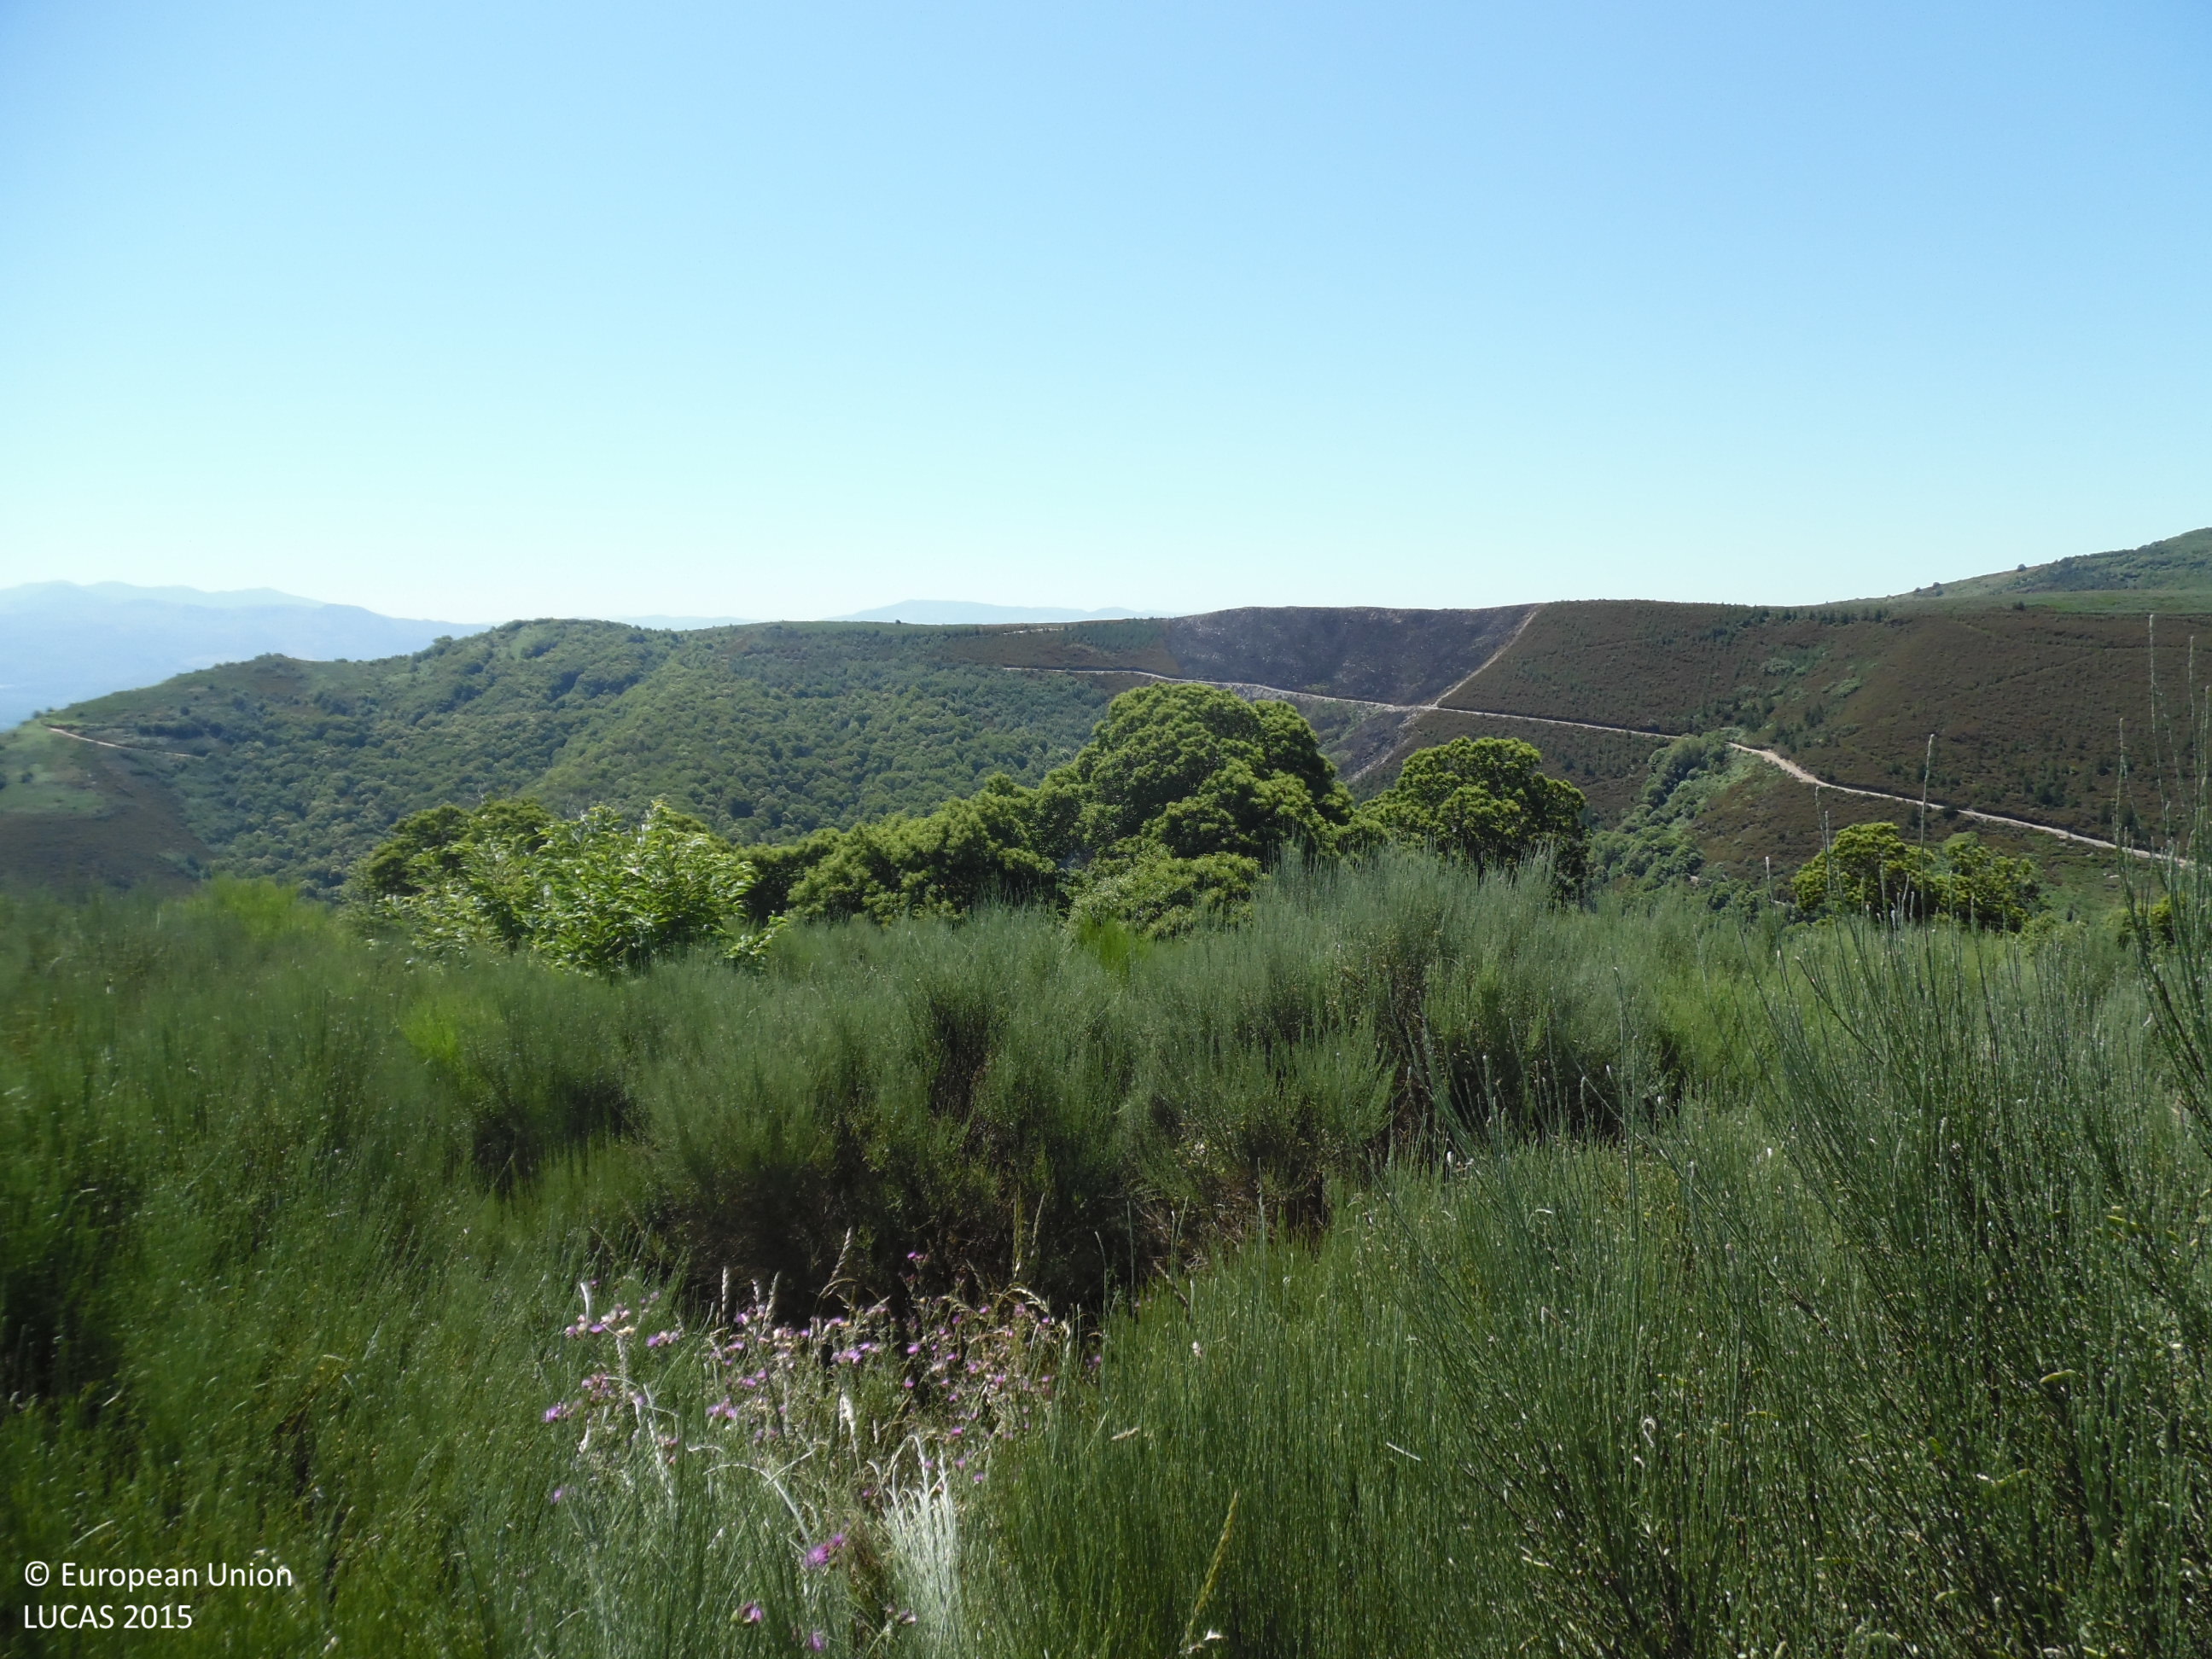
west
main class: Shrubland
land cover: Shrubland without tree cover
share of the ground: > 75 %
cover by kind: shrubs 100 %
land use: Abandoned areas
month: June
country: ES
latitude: 42.6086
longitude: -6.8634
